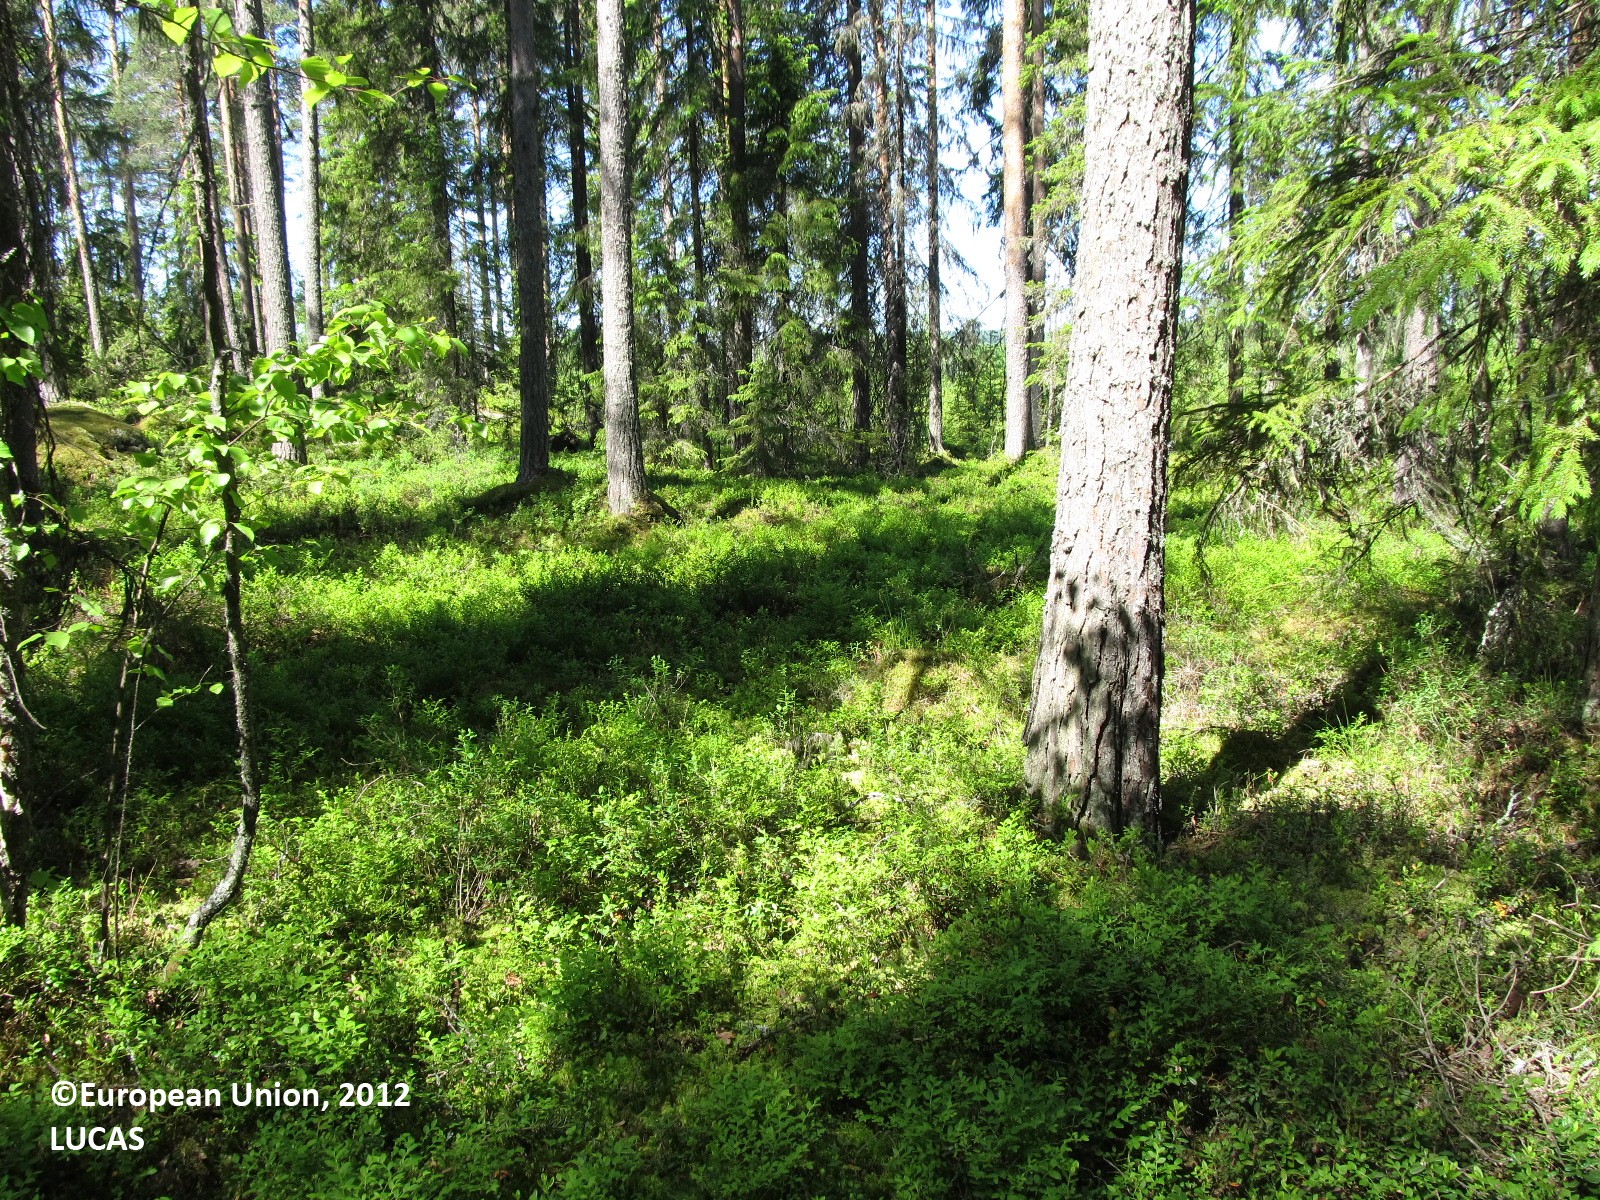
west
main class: Woodland
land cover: Other coniferous woodland
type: boreal forest
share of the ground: 25 - 50 %
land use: Forestry
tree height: > 5 m
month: June
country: FI
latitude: 62.9925
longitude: 27.7571
